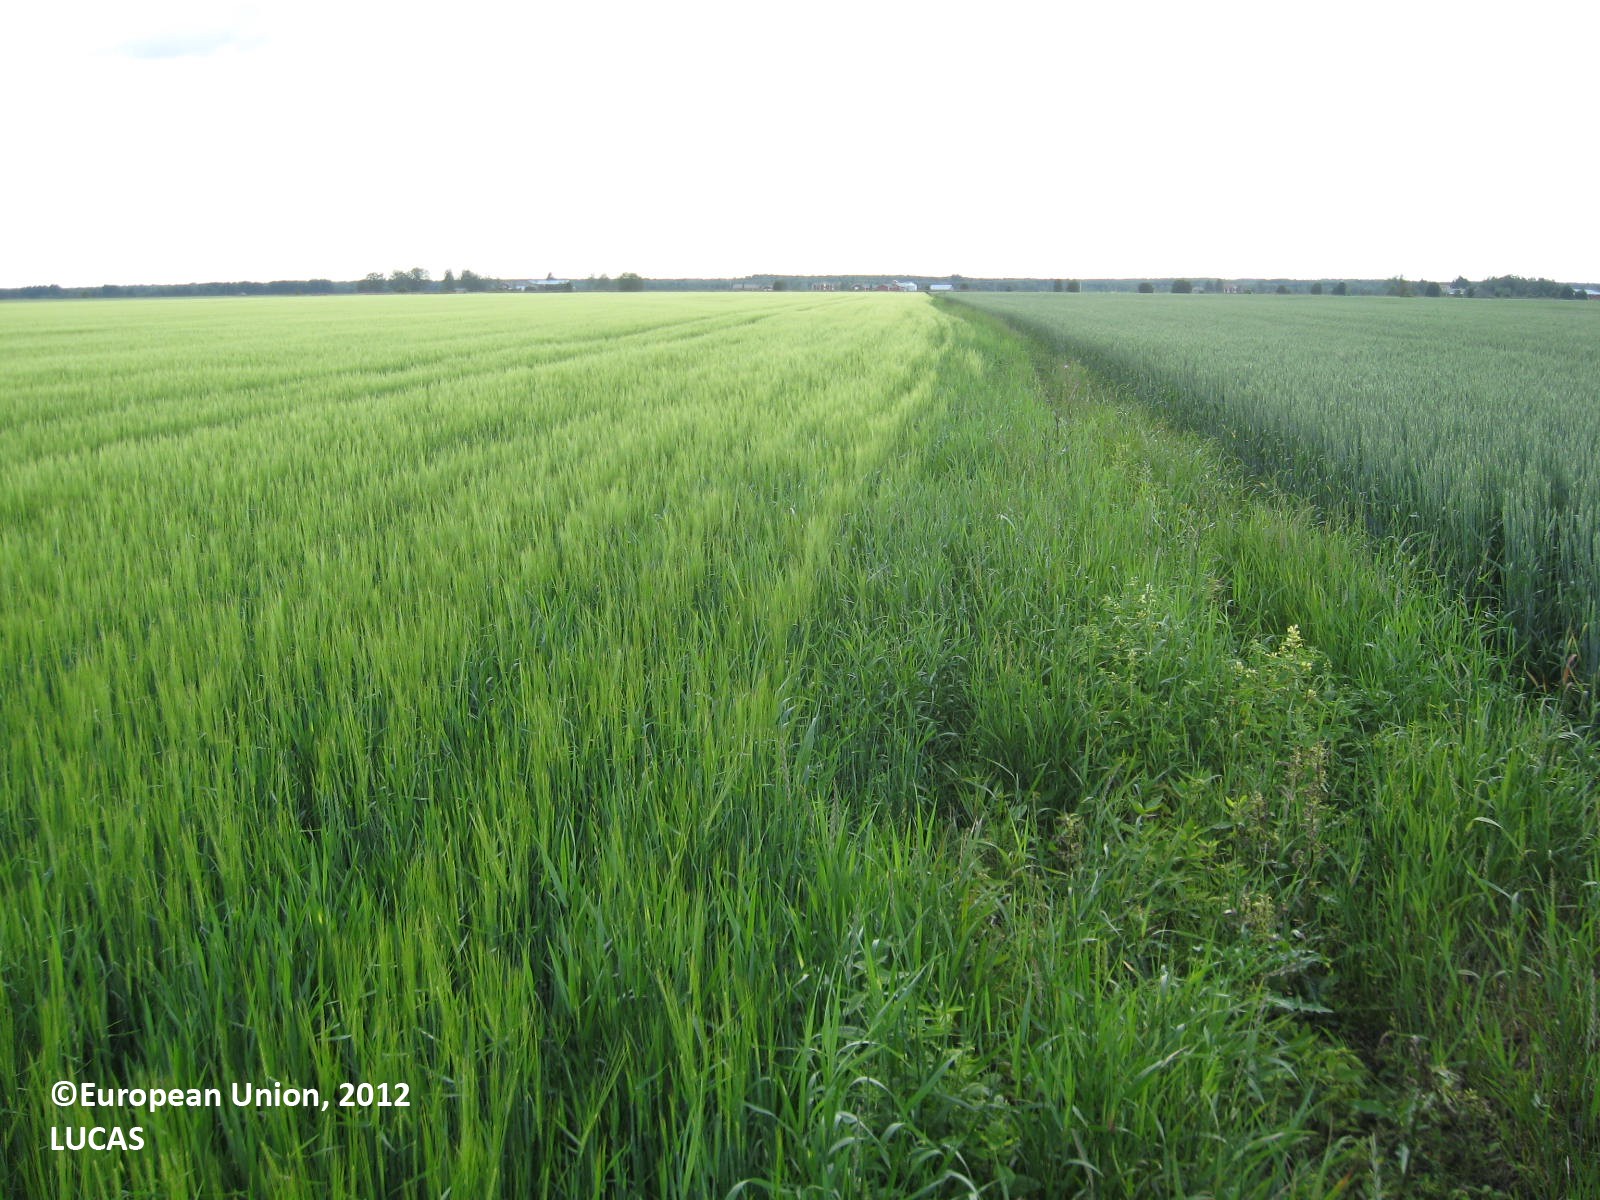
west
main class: Cropland
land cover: Barley
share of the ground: > 75 %
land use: Agriculture (excluding fallow land and kitchen gardens)
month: July
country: FI
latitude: 62.5745
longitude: 21.4661
